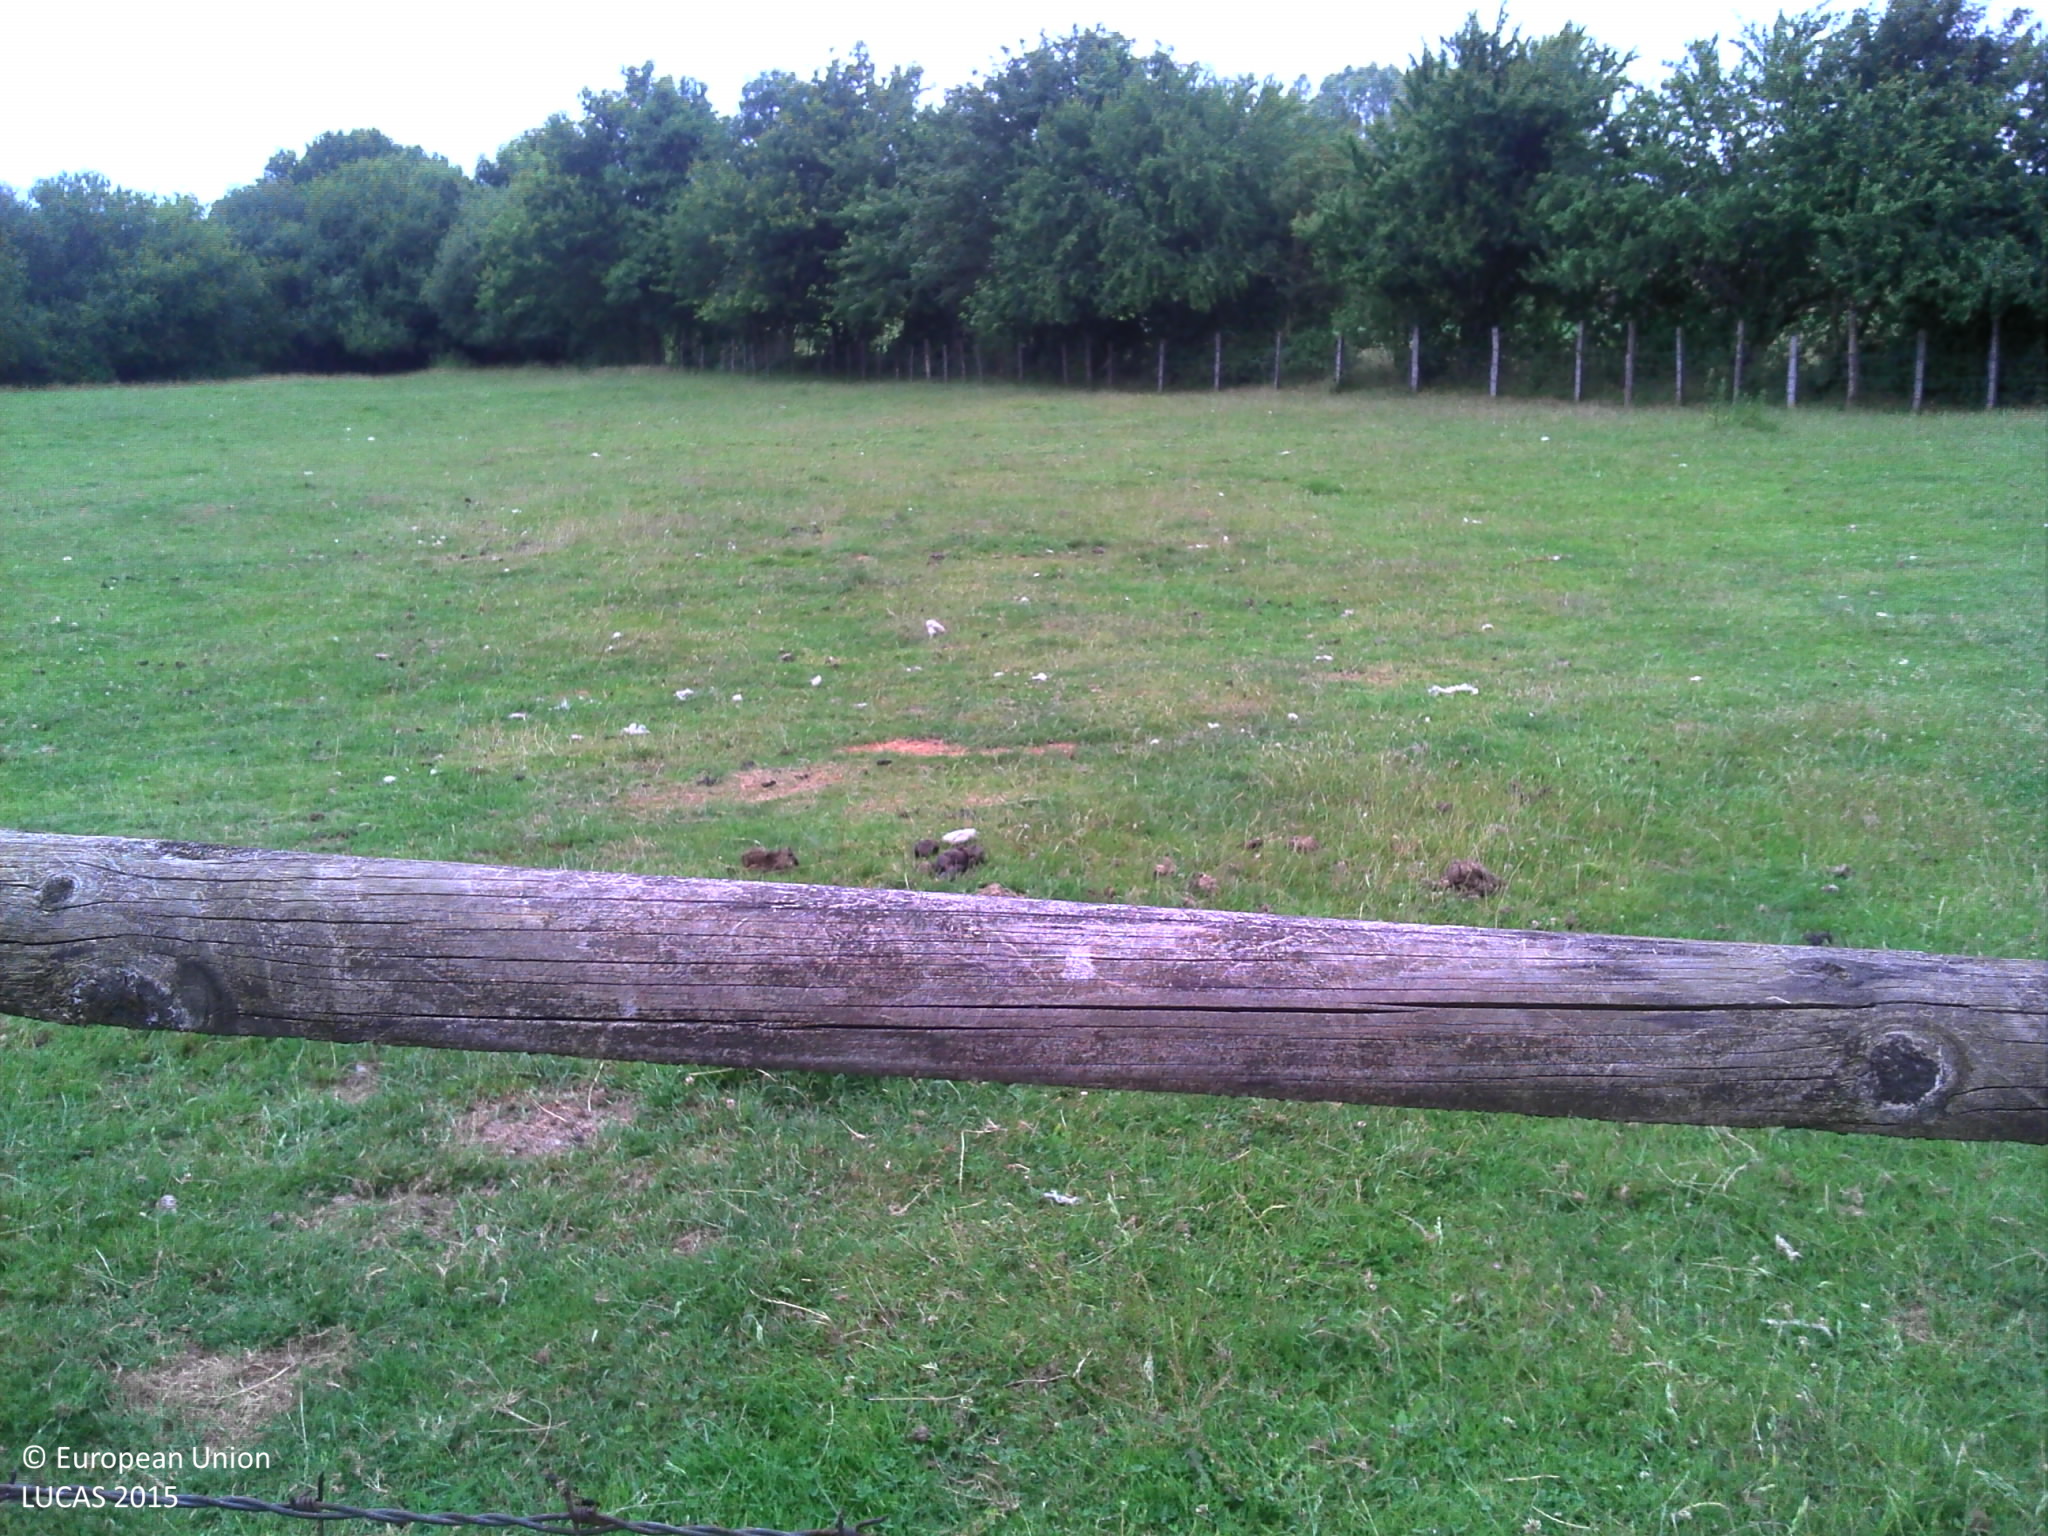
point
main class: Grassland
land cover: Grassland without tree/shrub cover
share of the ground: > 75 %
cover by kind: herbaceous plants 100 %
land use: Agriculture (excluding fallow land and kitchen gardens)
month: June
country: FR
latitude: 48.1129
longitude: 0.2087
